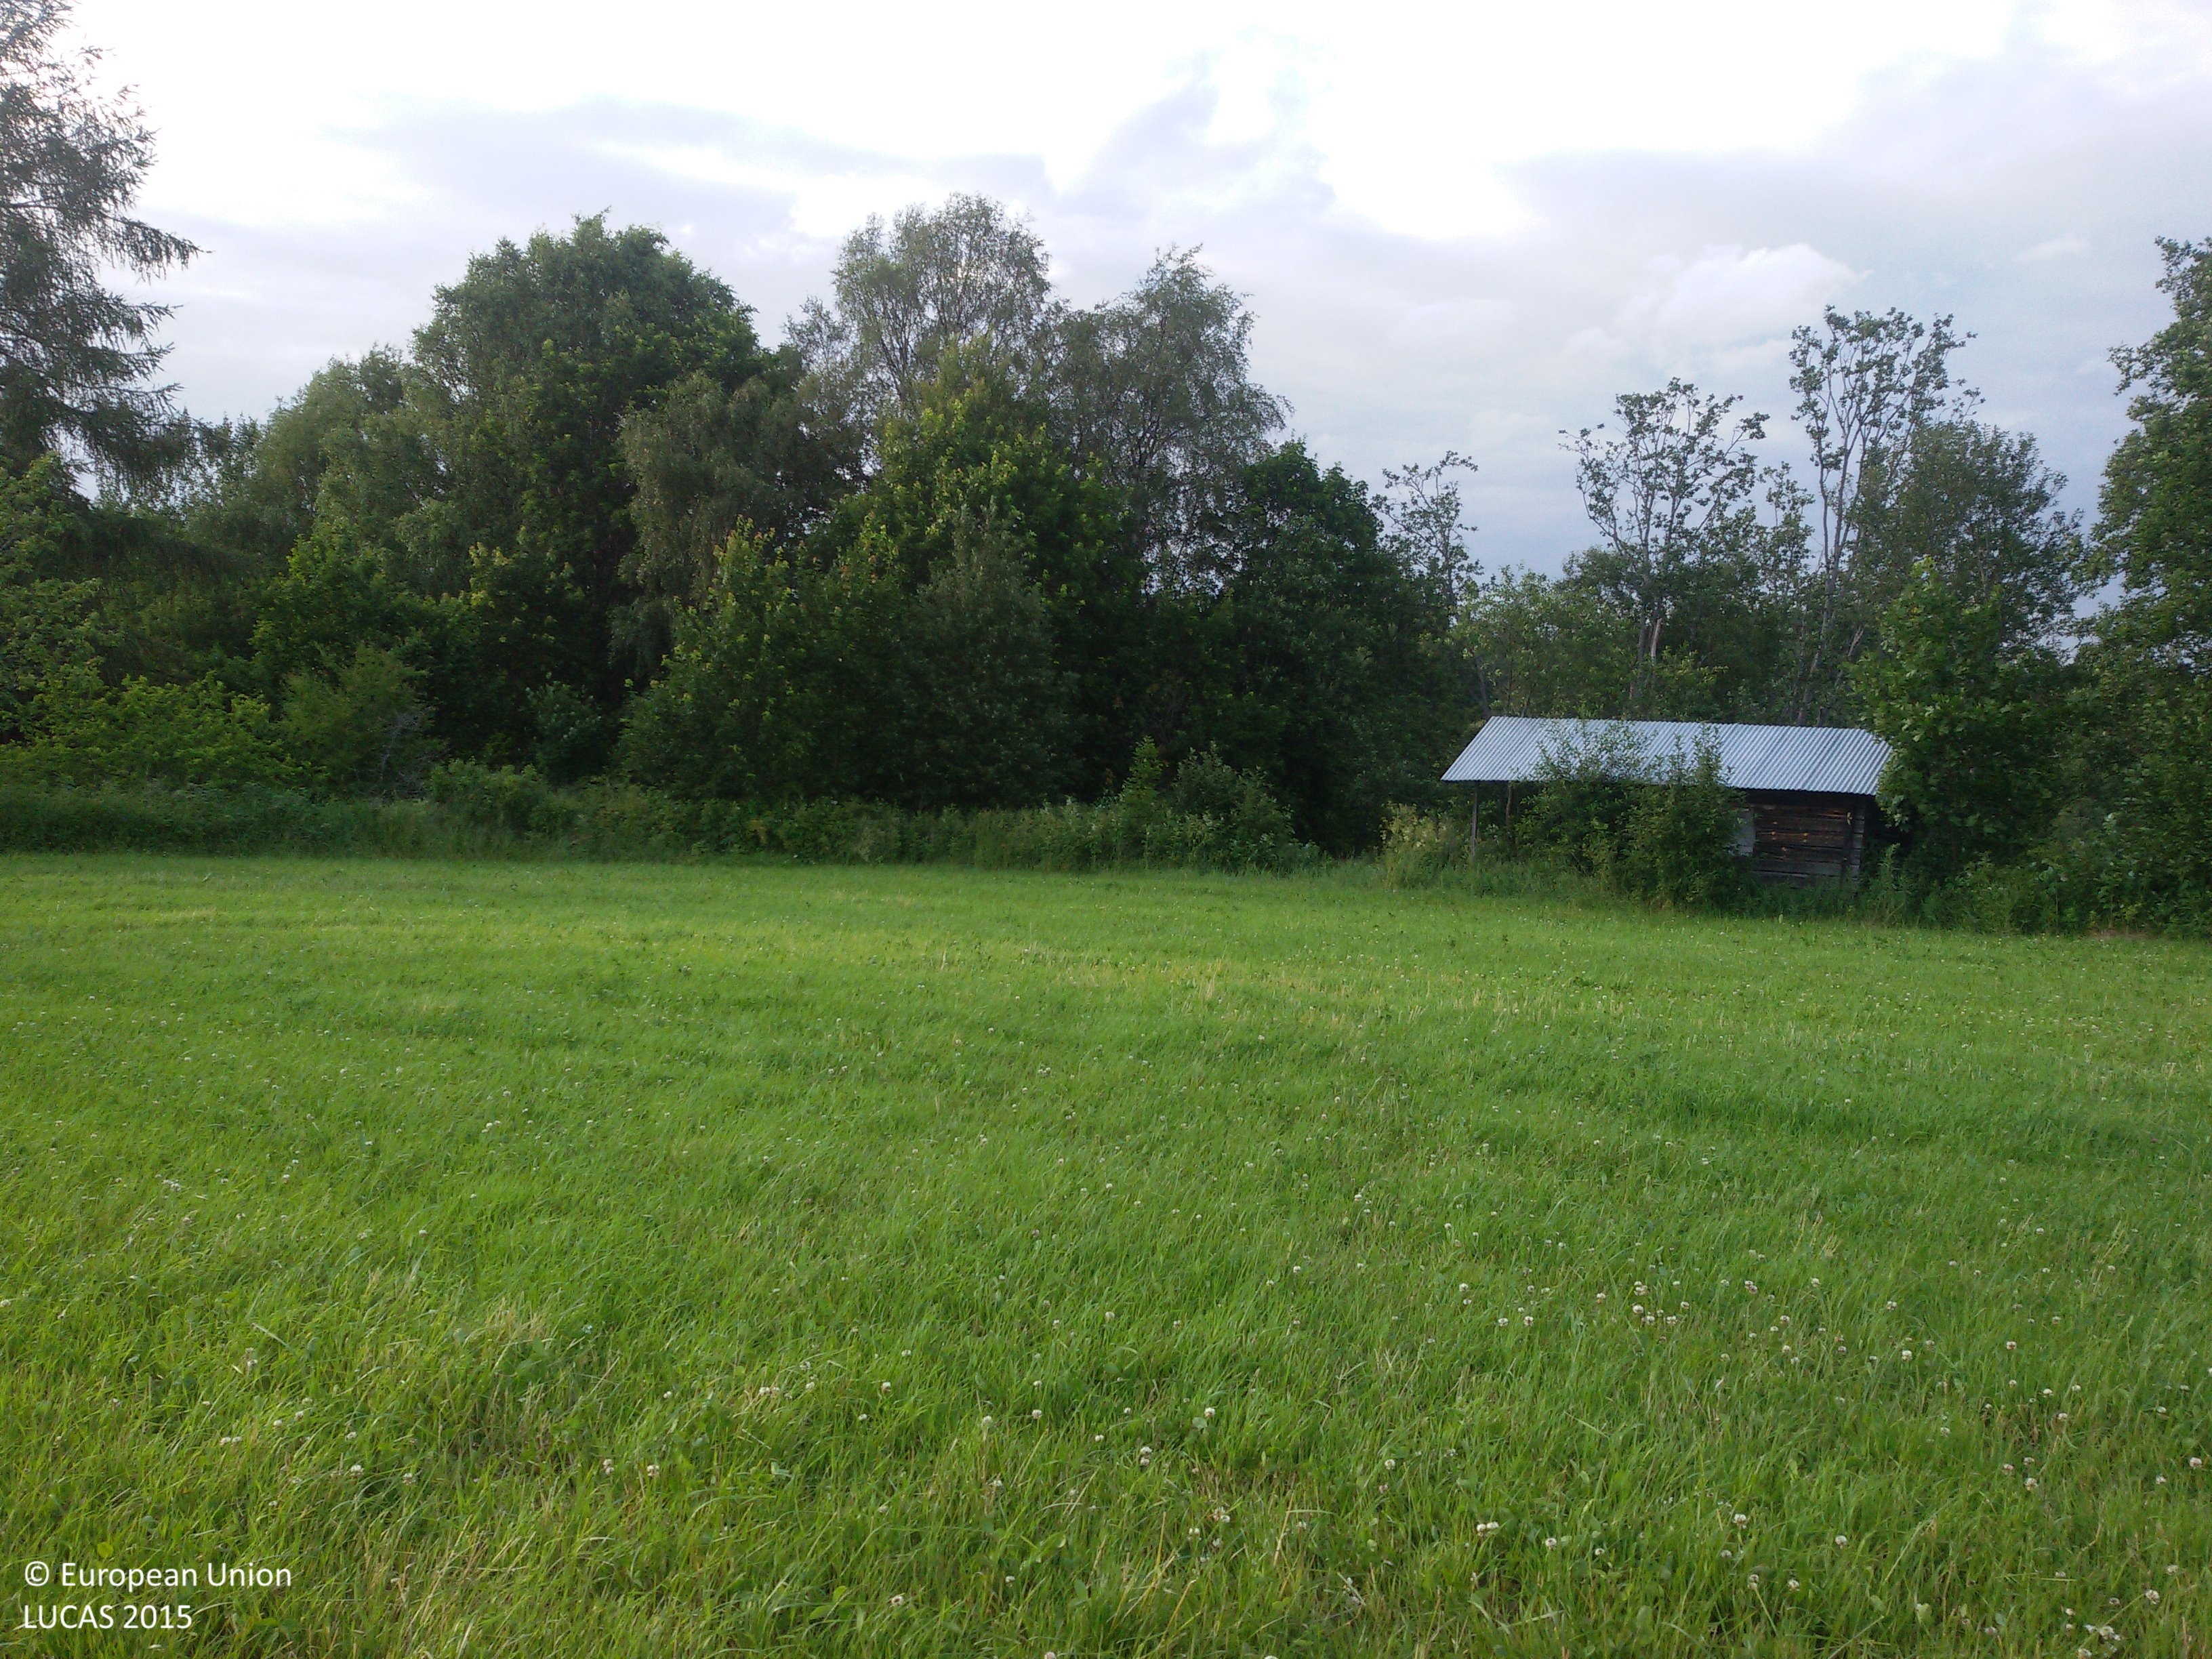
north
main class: Grassland
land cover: Grassland without tree/shrub cover
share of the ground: > 75 %
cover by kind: herbaceous plants 100 %
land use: Agriculture (excluding fallow land and kitchen gardens)
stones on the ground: < 10 %
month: July
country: SE
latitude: 60.5120
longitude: 15.3603
